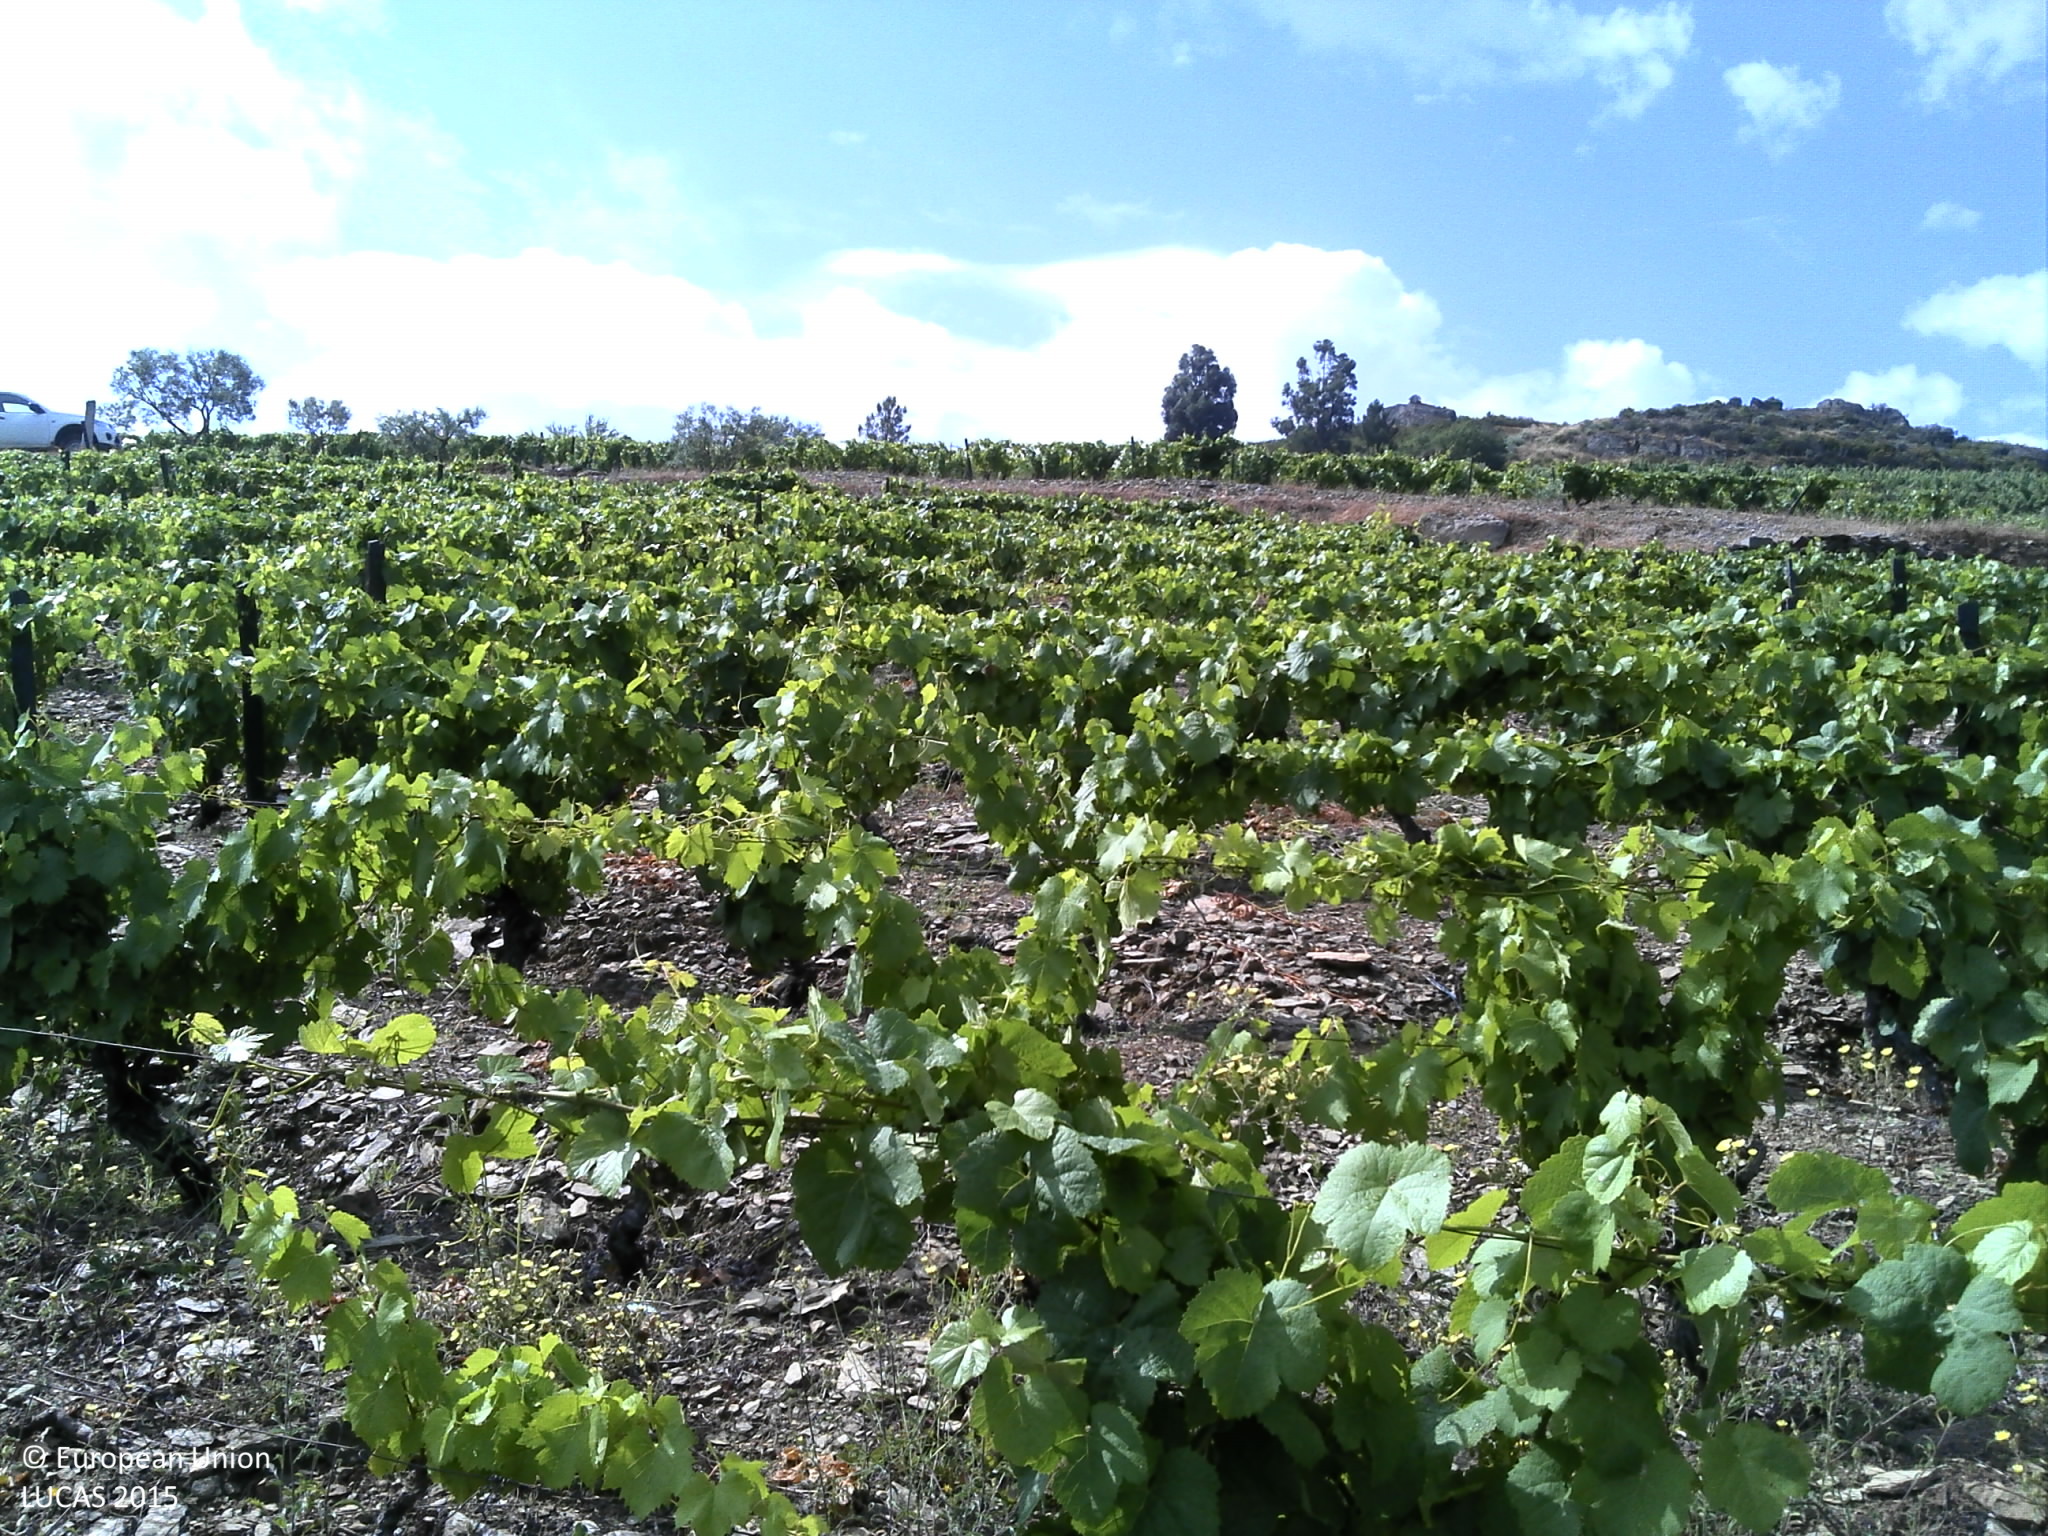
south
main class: Cropland
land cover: Vineyards
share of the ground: 10 - 25 %
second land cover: Spontaneously vegetated surfaces
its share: < 10 %
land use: Agriculture (excluding fallow land and kitchen gardens)
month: June
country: PT
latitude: 41.1912
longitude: -7.4940
